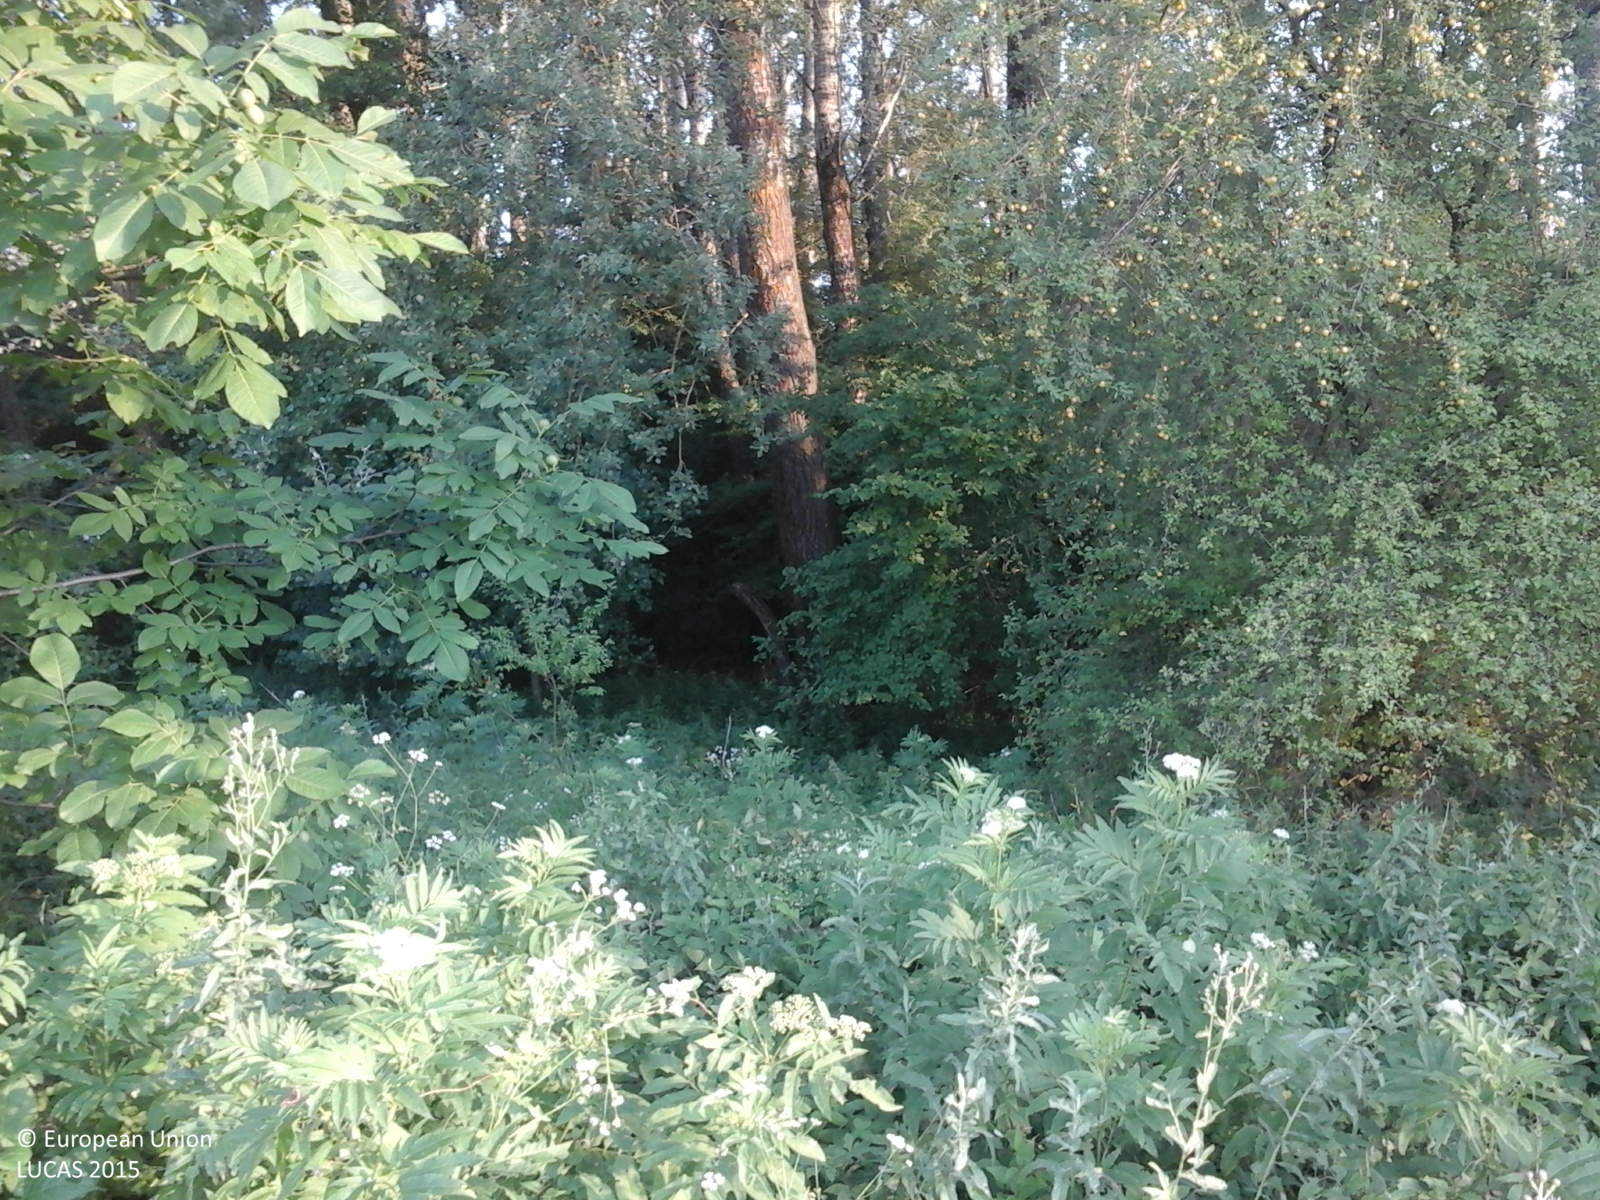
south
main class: Woodland
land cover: Broadleaved woodland
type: non-riverine alder, birch or aspen forest
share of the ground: > 75 %
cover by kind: broadleaved forest trees 100 %
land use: Forestry
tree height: > 5 m
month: July
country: RO
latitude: 44.7017
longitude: 25.6068
